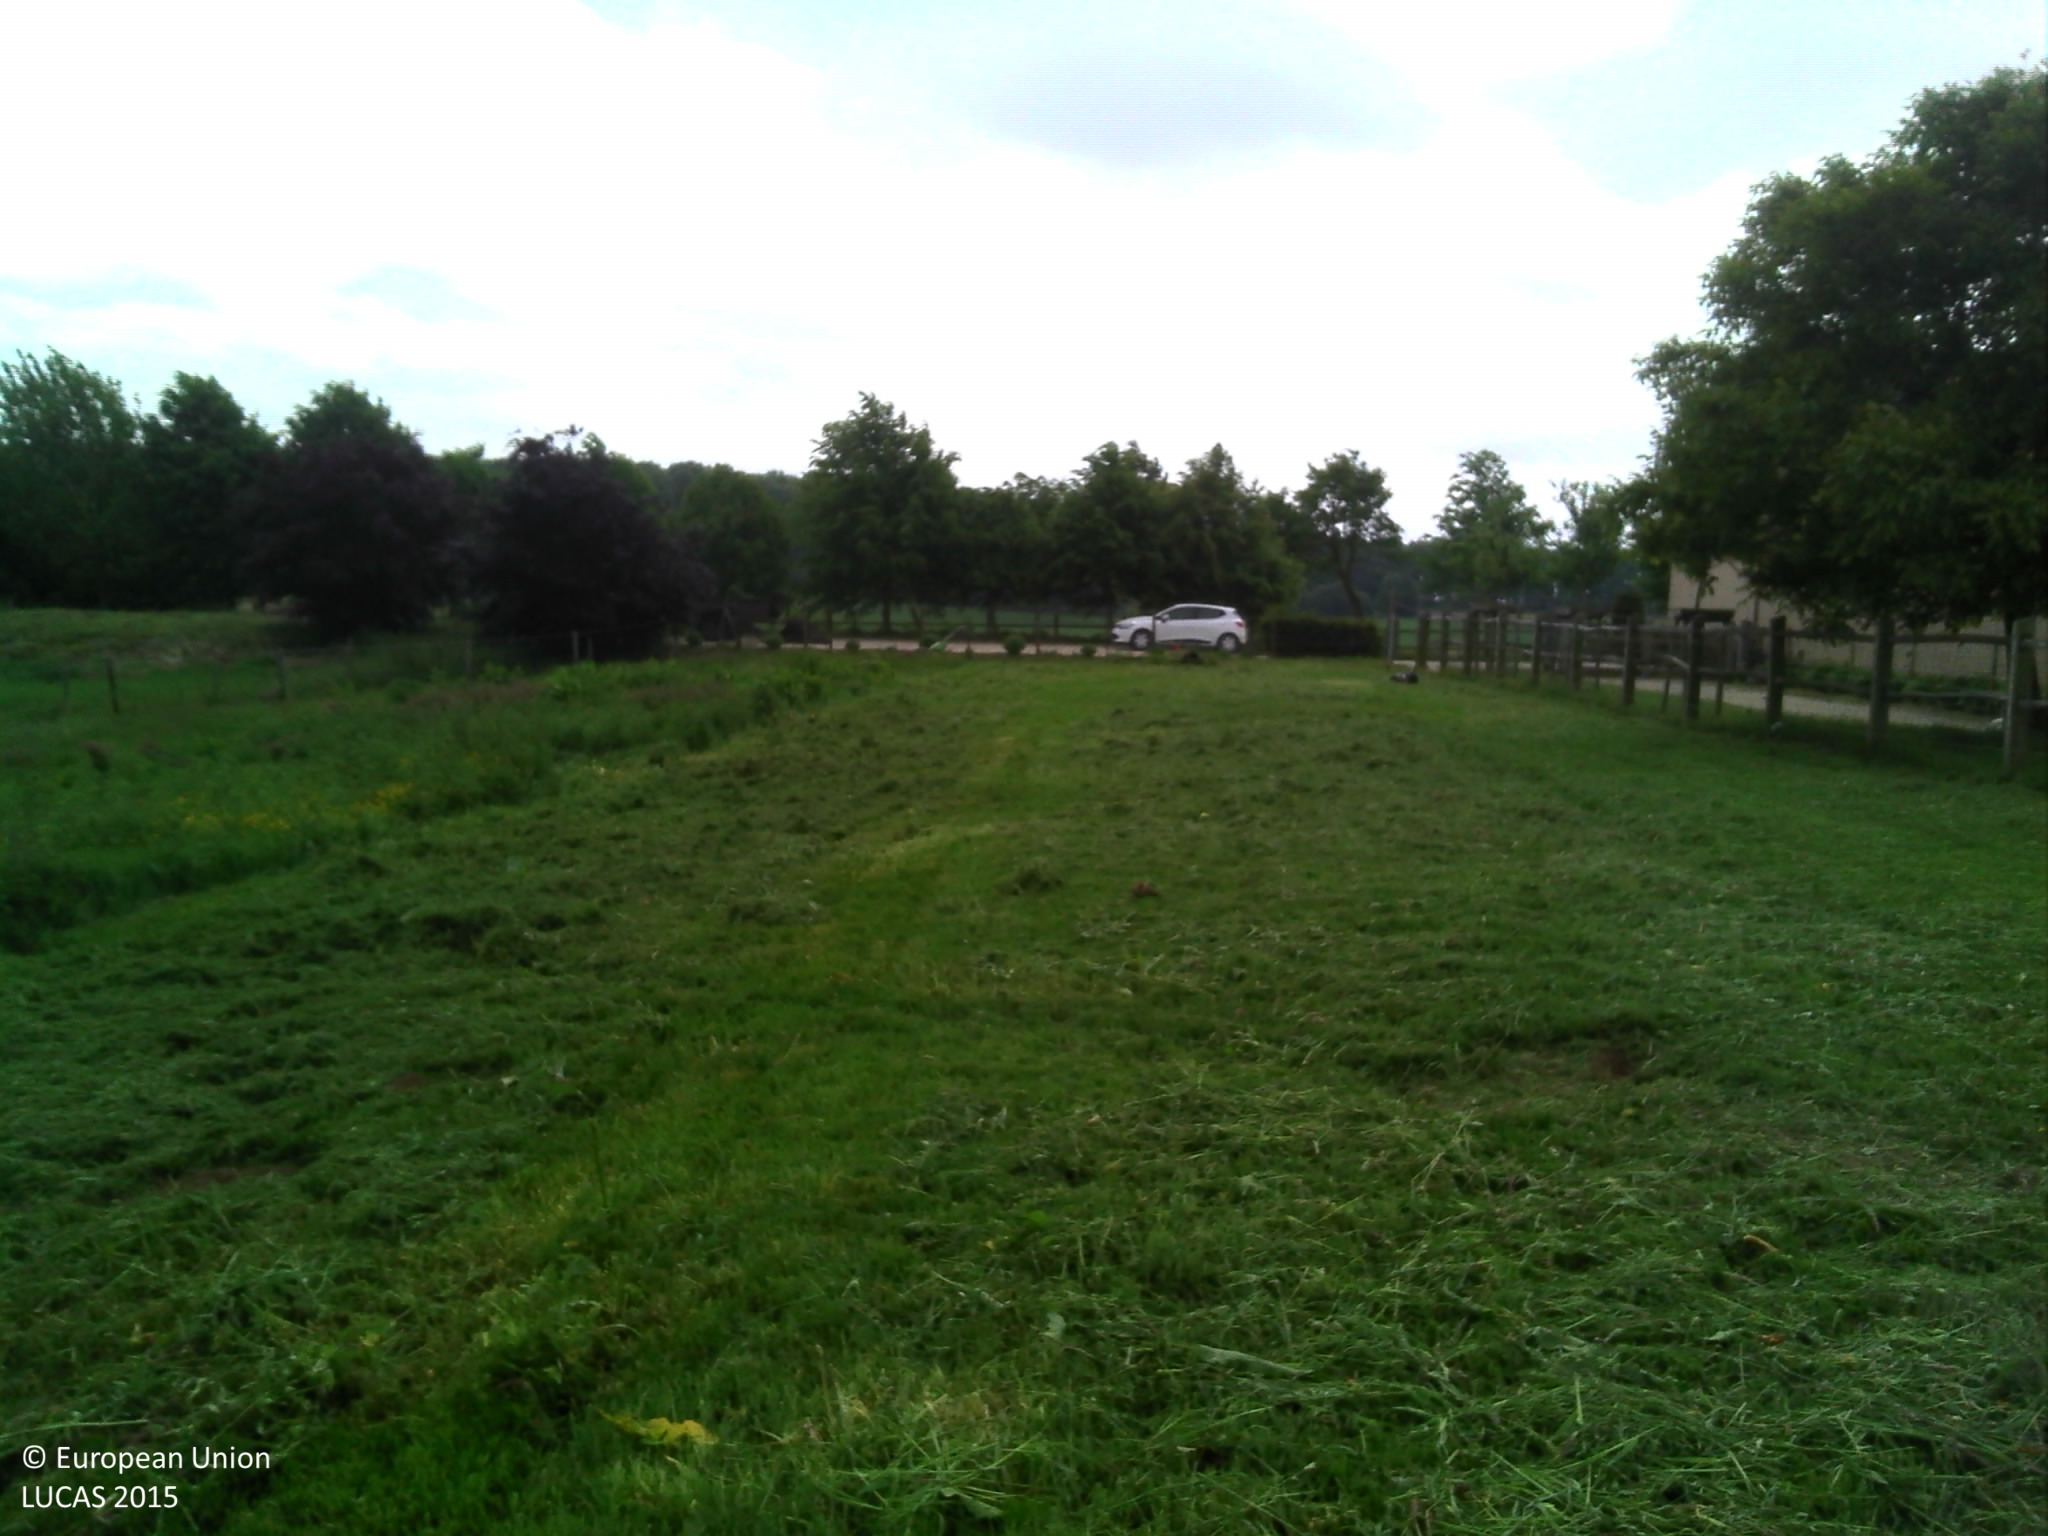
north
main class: Grassland
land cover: Grassland without tree/shrub cover
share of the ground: > 75 %
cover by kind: herbaceous plants 100 %
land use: Agriculture (excluding fallow land and kitchen gardens)
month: May
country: BE
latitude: 50.6268
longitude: 4.4684
